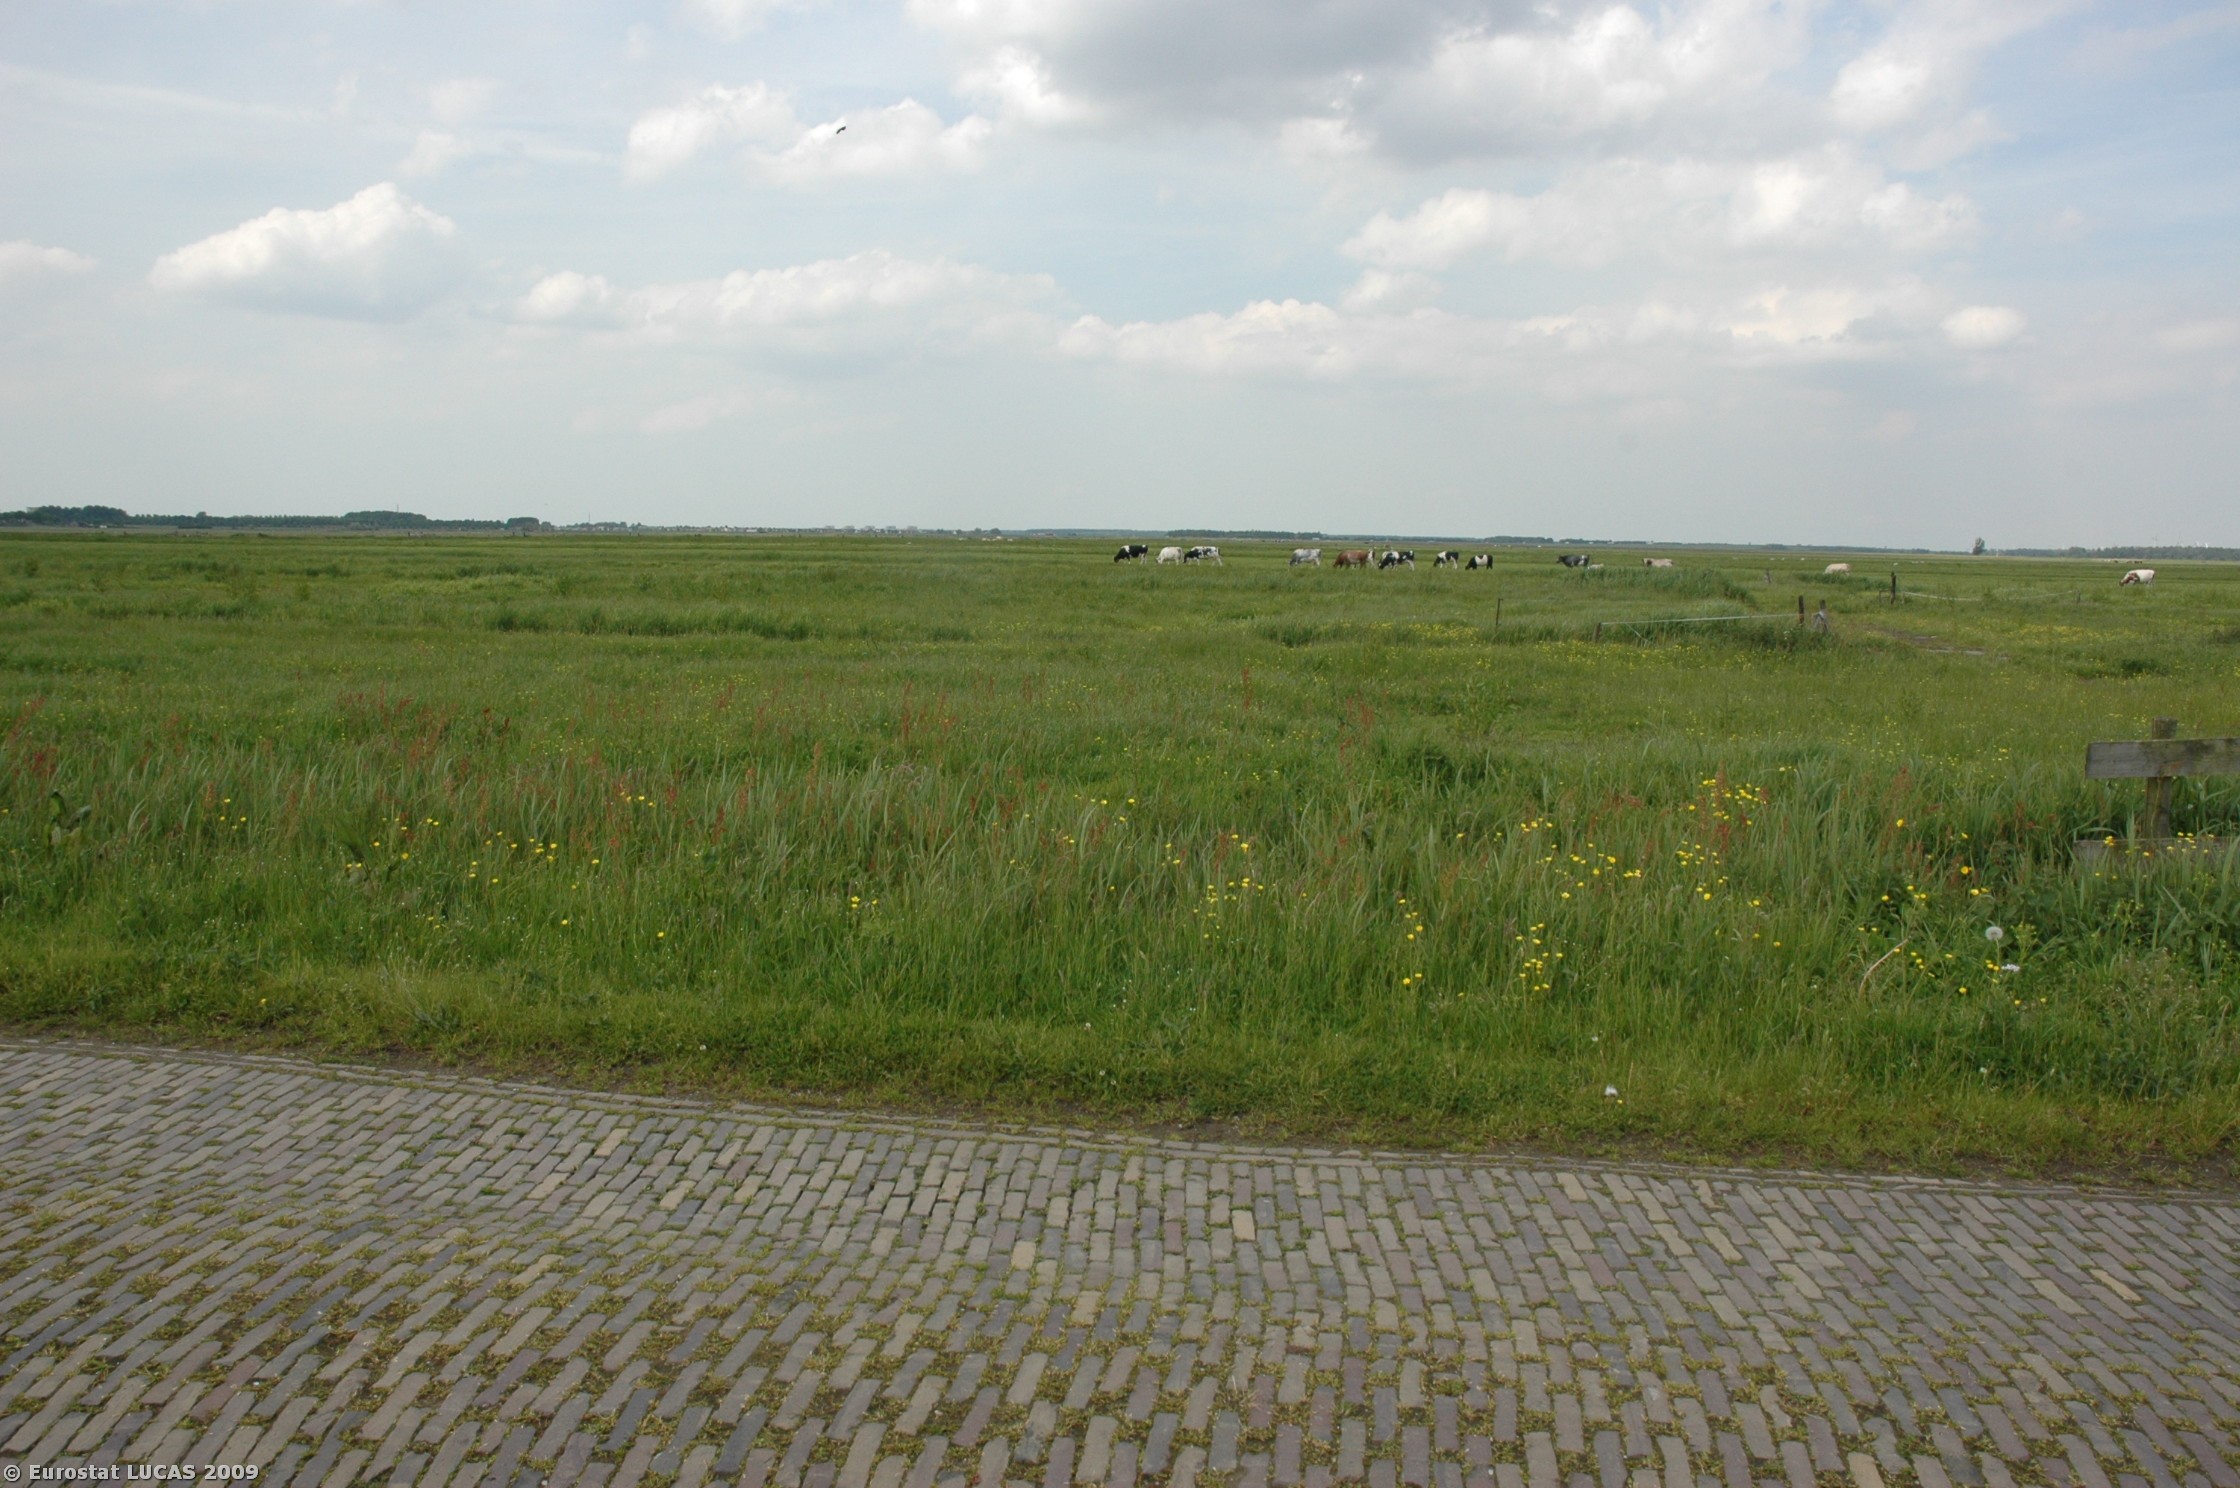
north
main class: Grassland
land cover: Grassland without tree/shrub cover
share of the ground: > 75 %
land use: Agriculture (excluding fallow land and kitchen gardens)
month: May
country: NL
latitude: 52.2662
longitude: 5.2943
